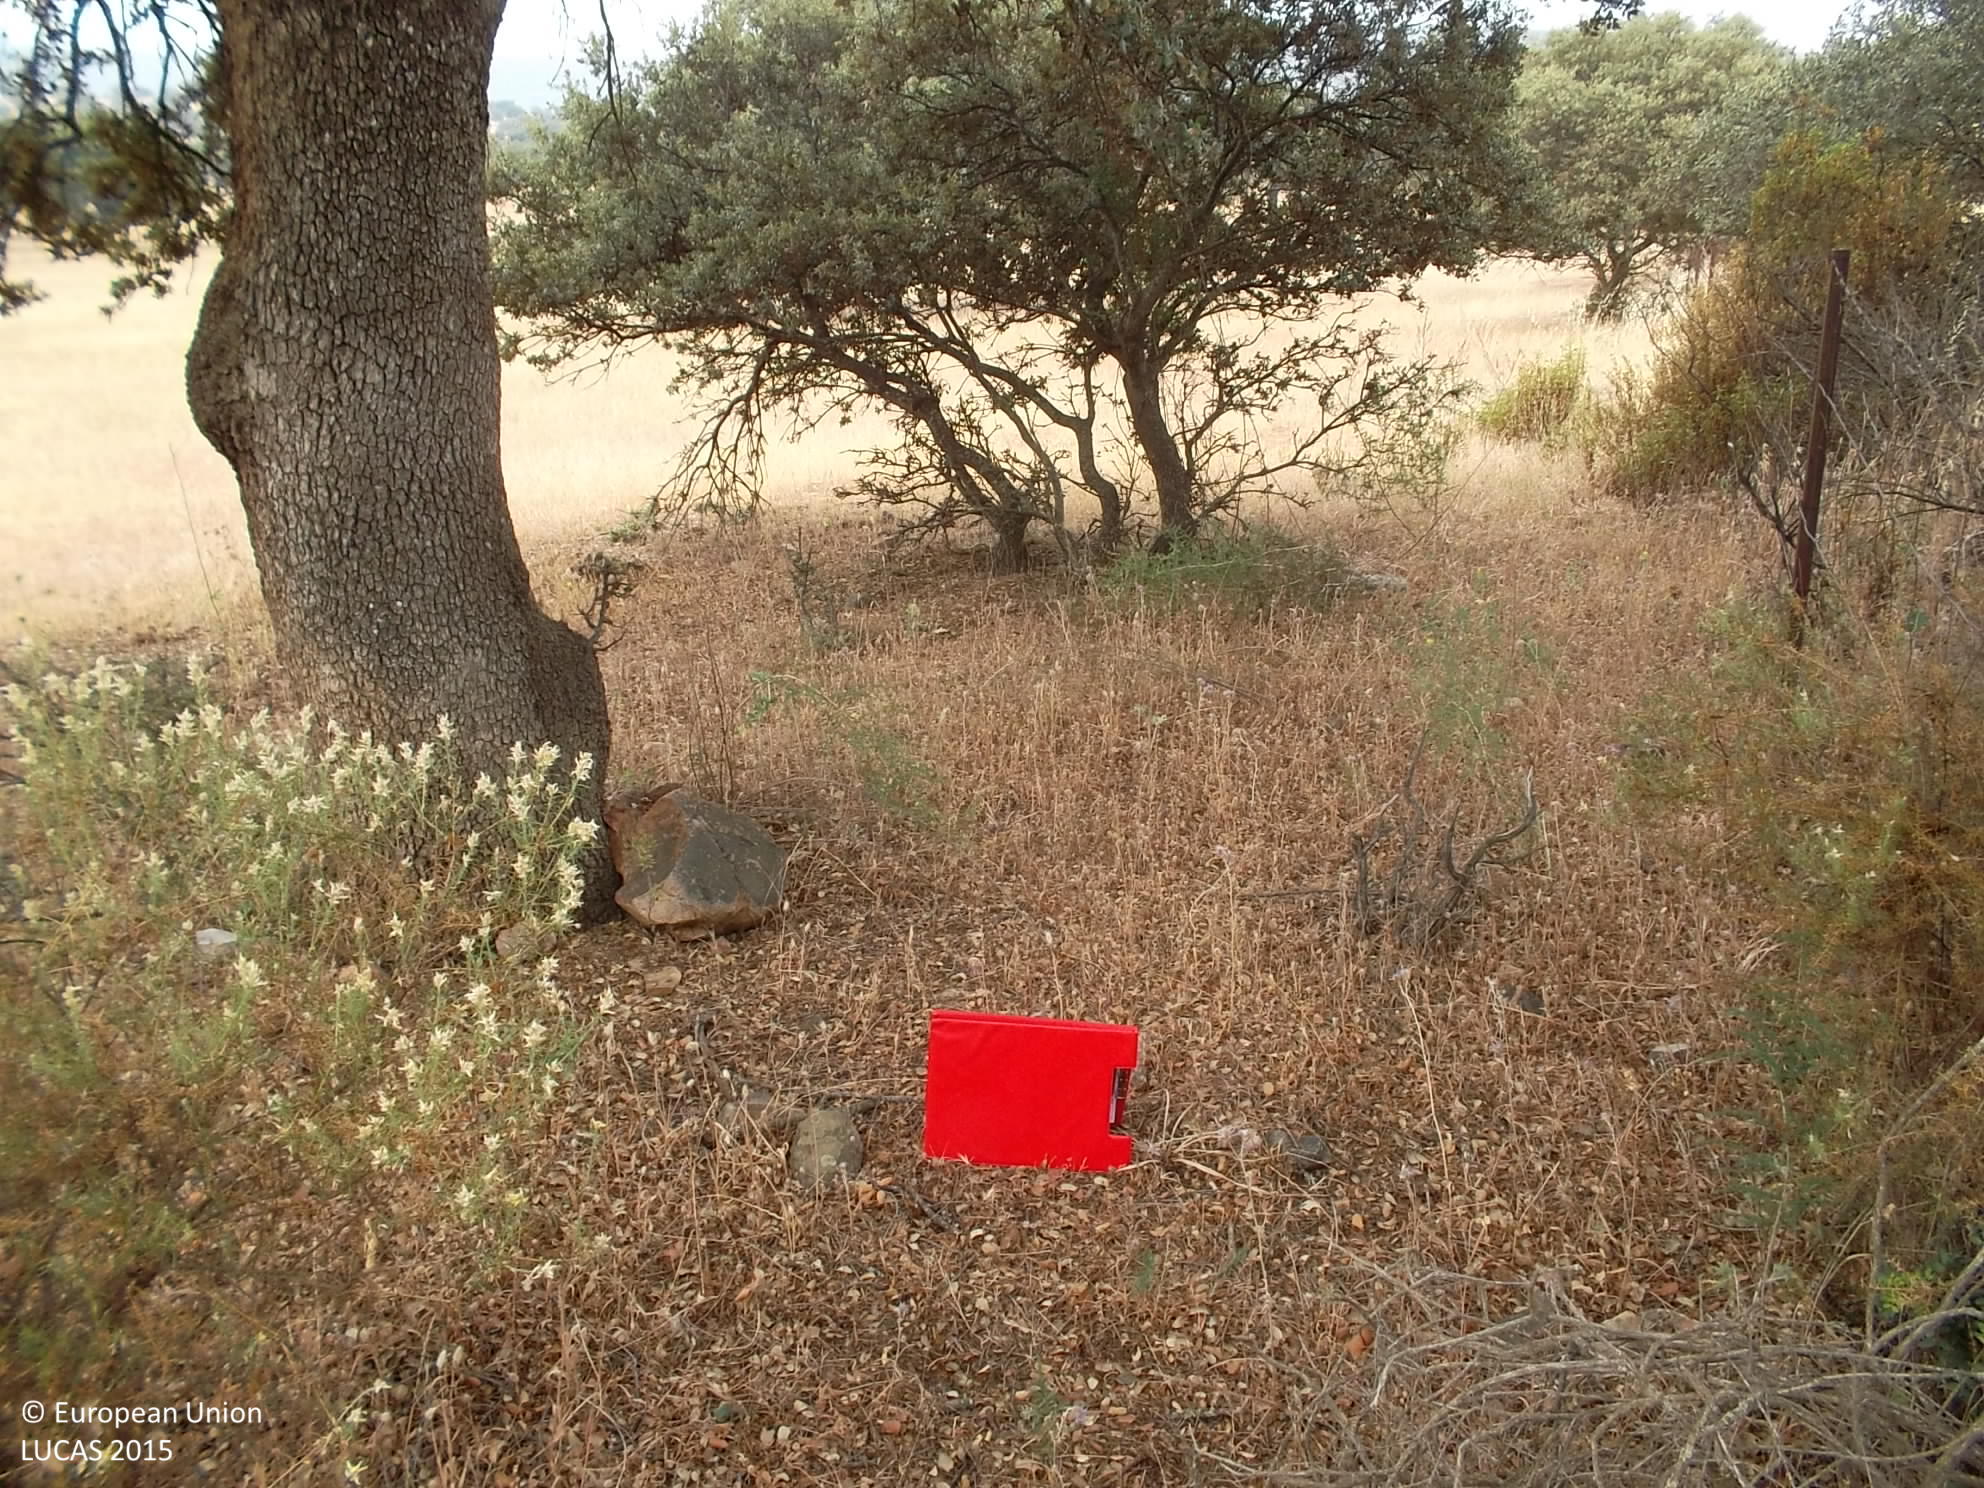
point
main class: Woodland
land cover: Broadleaved woodland
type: broadleaved evergreen forest
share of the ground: 25 - 50 %
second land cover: Grassland without tree/shrub cover
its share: > 75 %
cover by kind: broadleaved forest trees 30 %, herbaceous plants 30 %, shrubs 20 %, unconsolidated bare surface 20 %
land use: Forestry
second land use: Agriculture (excluding fallow land and kitchen gardens)
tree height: > 5 m
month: June
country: ES
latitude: 39.0219
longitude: -4.4777
